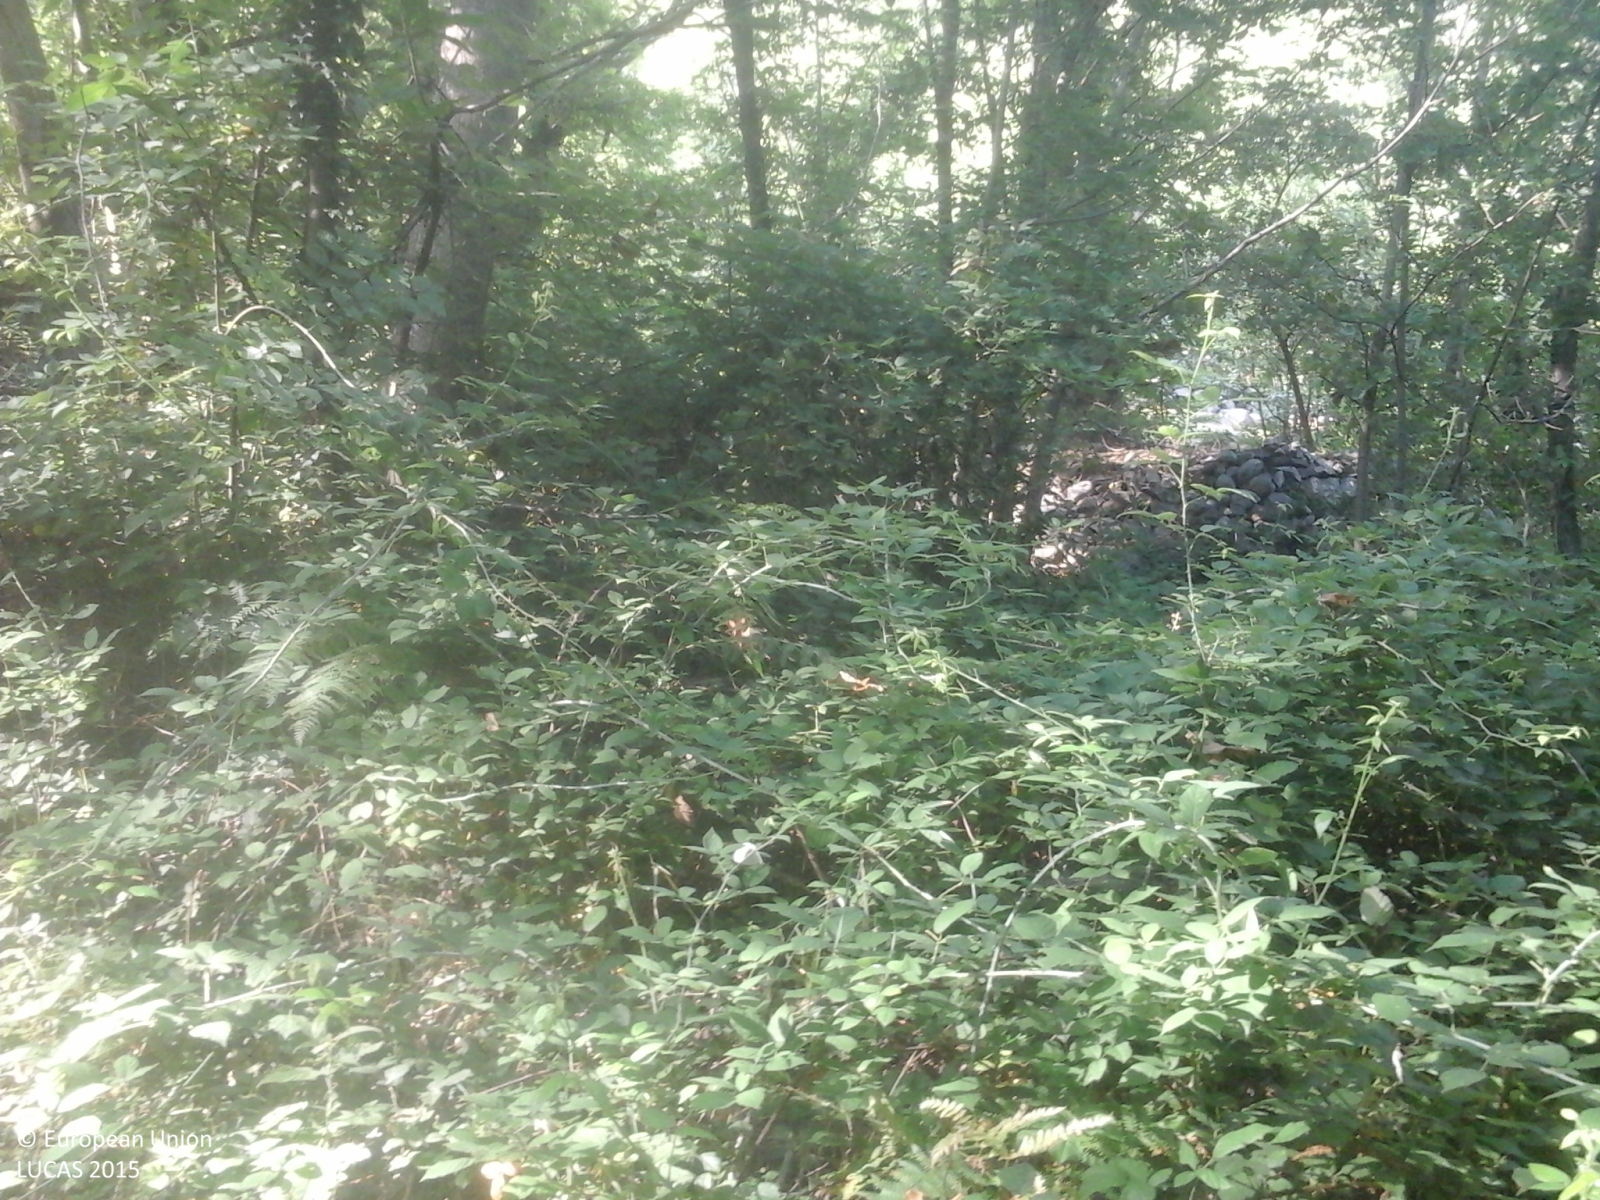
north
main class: Woodland
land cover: Broadleaved woodland
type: thermophilous deciduous forest
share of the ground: > 75 %
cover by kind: broadleaved forest trees 100 %
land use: Forestry
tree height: > 5 m
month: July
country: IT
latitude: 46.3316
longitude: 9.4162
